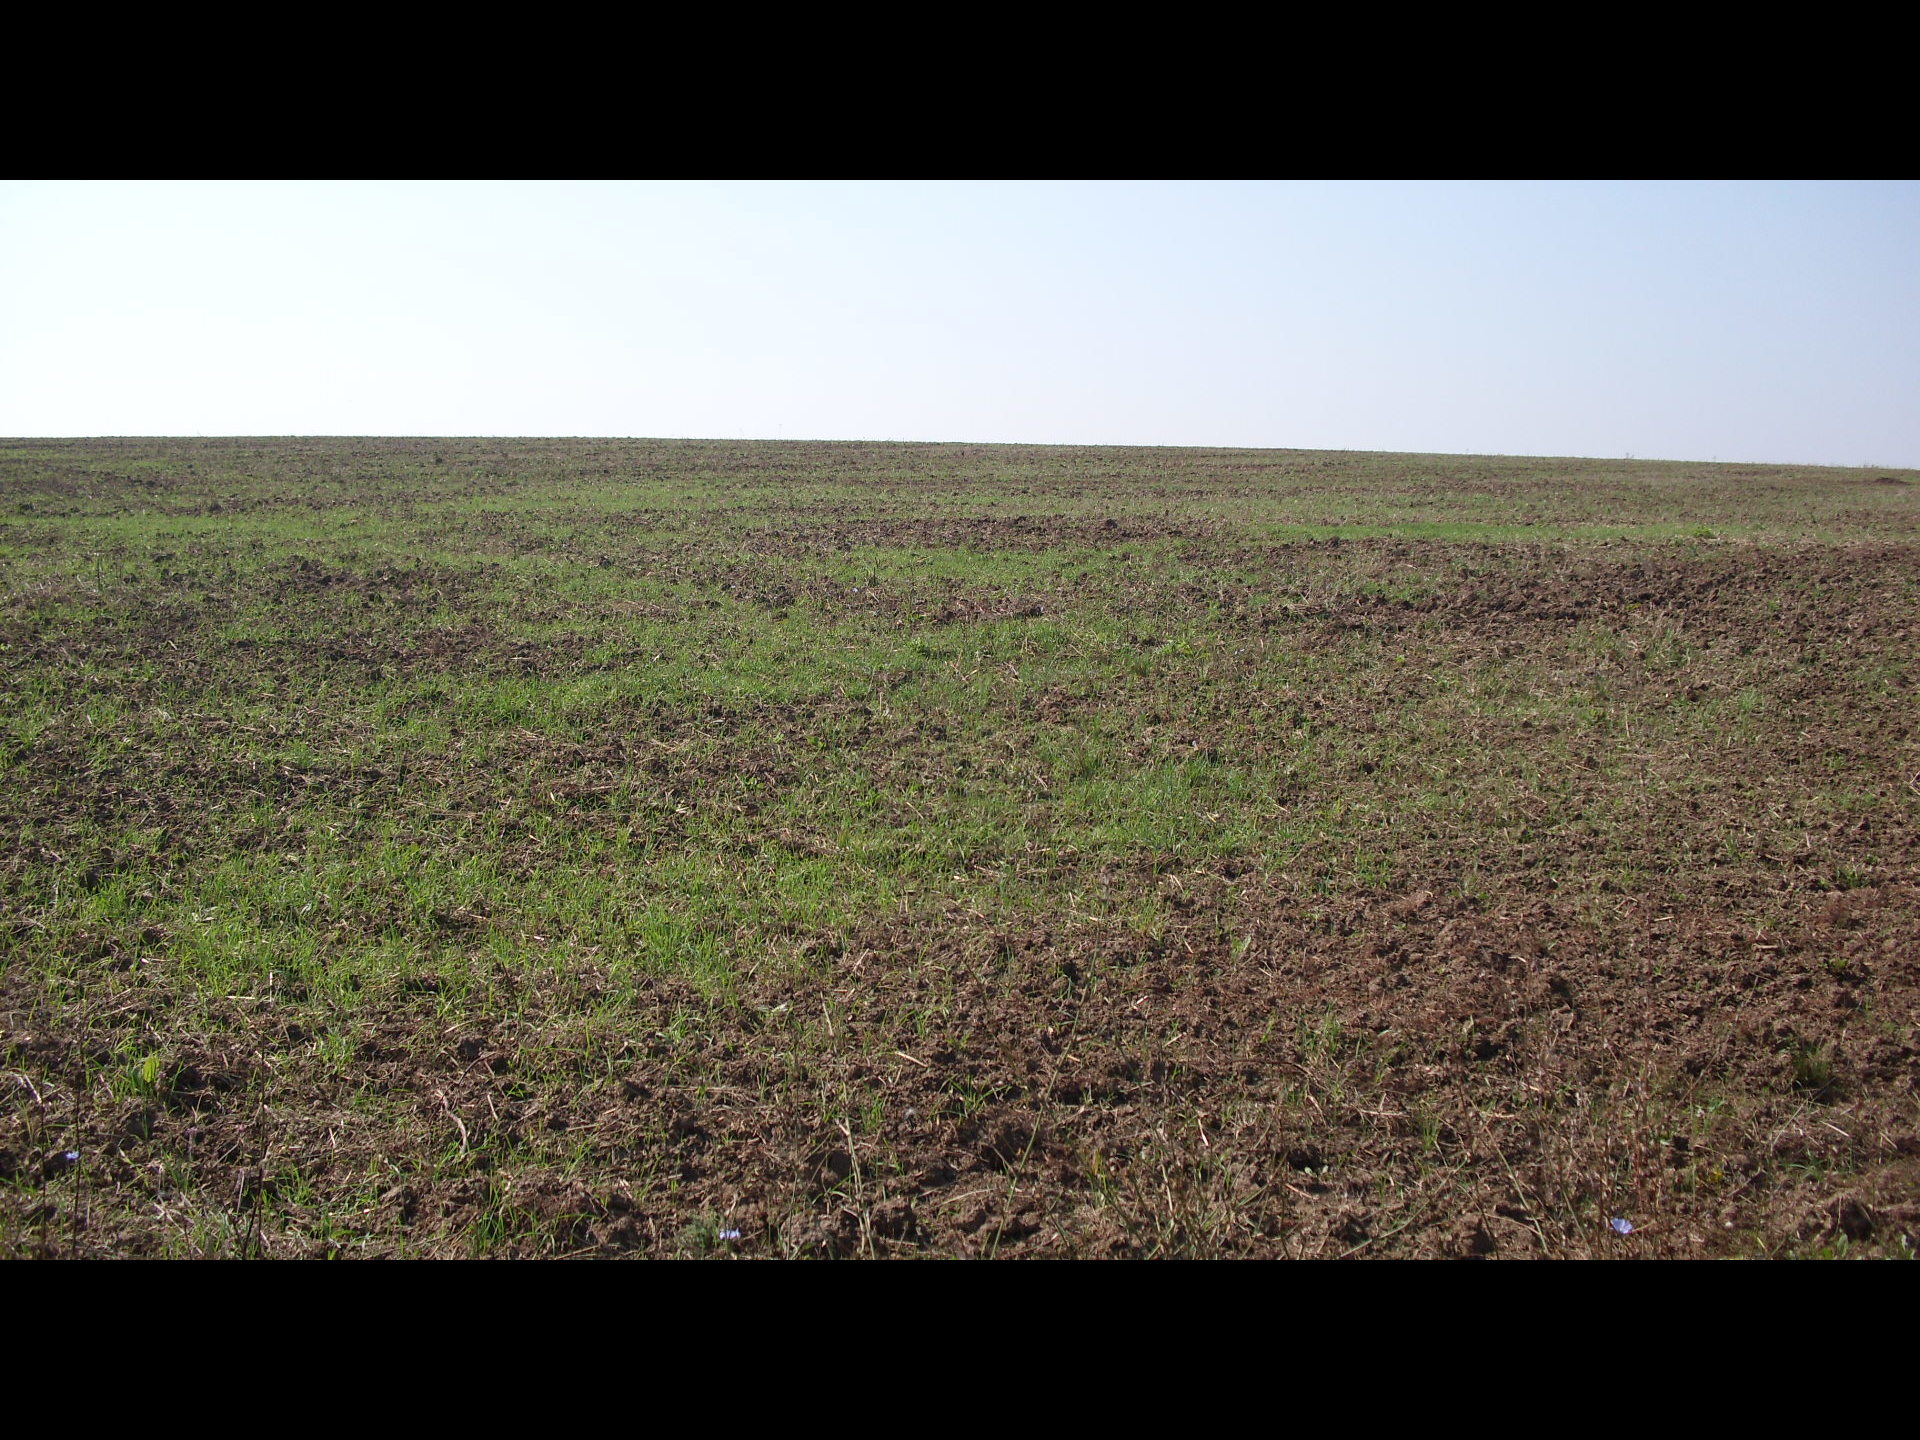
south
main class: Grassland
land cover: Grassland with sparse tree/shrub cover
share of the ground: > 75 %
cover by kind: herbaceous plants 85 %, shrubs 10 %, broadleaved forest trees 5 %
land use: Semi-natural and natural areas not in use
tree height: < 5 m
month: September
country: BG
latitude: 44.0409
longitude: 22.5524
